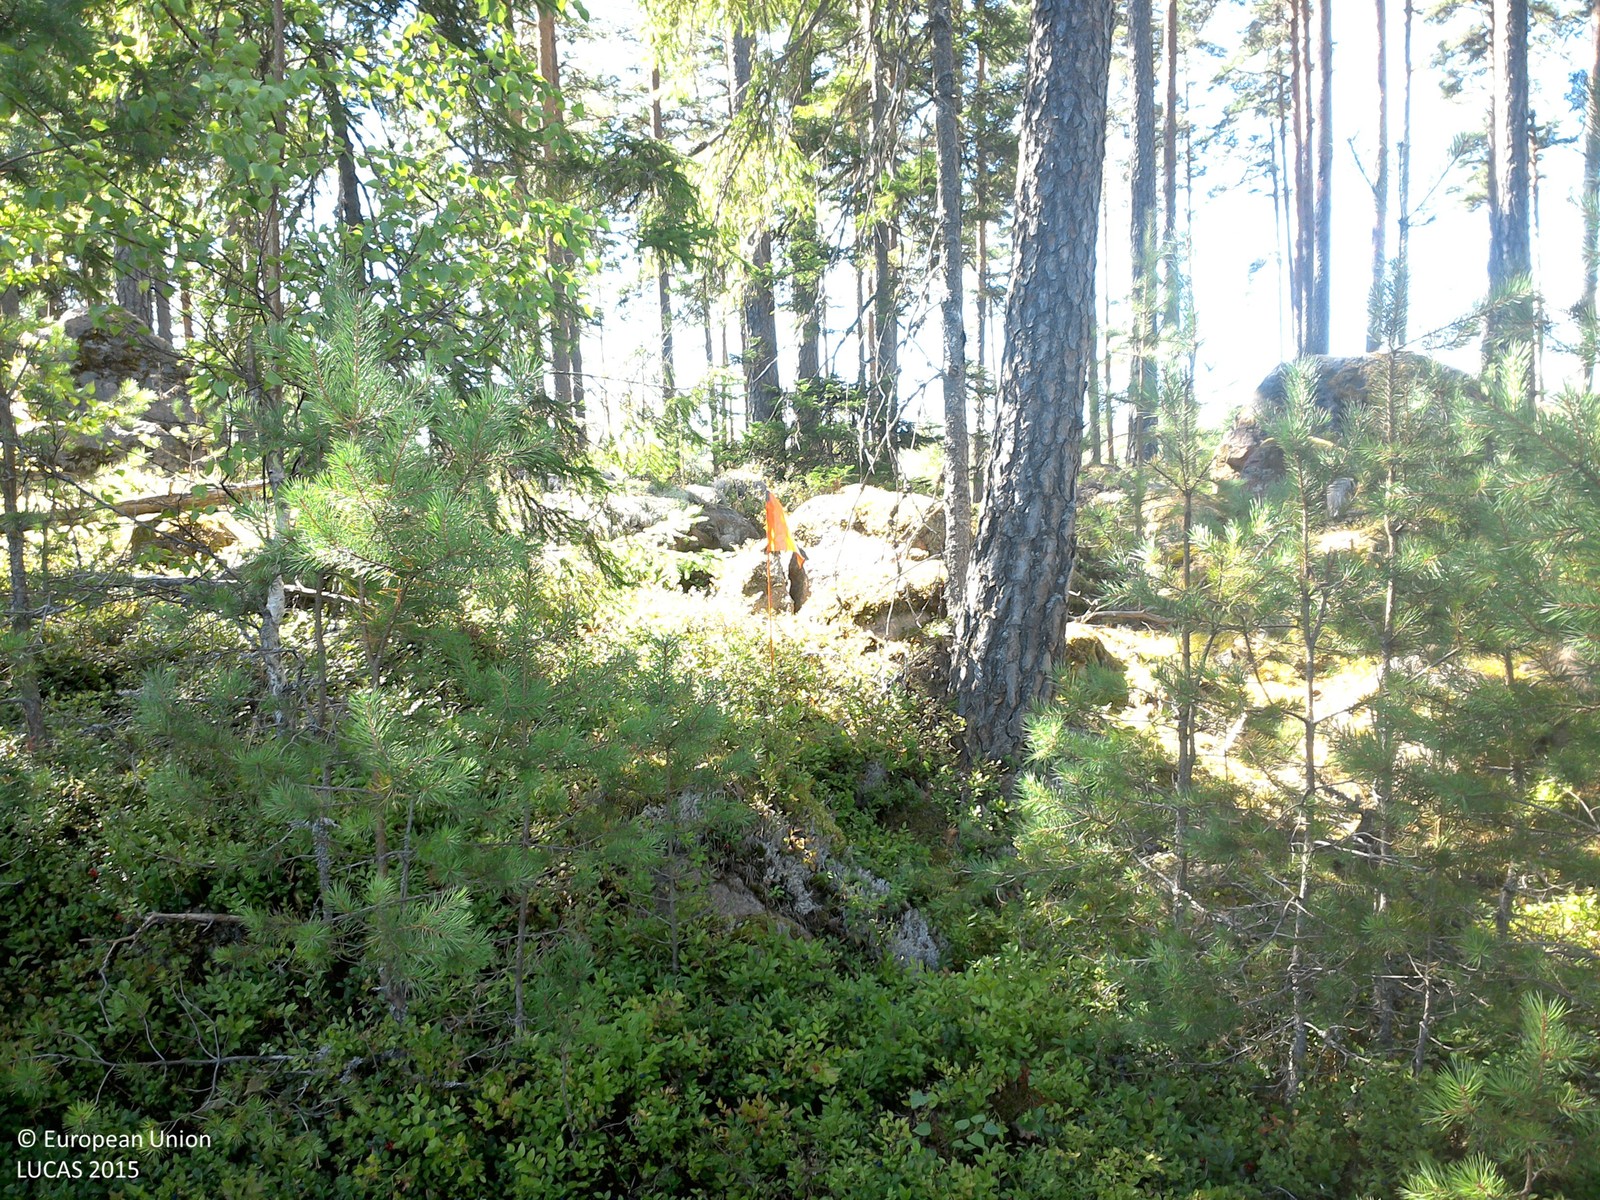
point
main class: Woodland
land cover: Pine dominated coniferous woodland
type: boreal forest
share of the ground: 25 - 50 %
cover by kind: lichens and mosses 45 %, coniferous forest trees 40 %, herbaceous plants 15 %
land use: Forestry
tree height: > 5 m
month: August
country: SE
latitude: 58.1340
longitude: 15.2765
